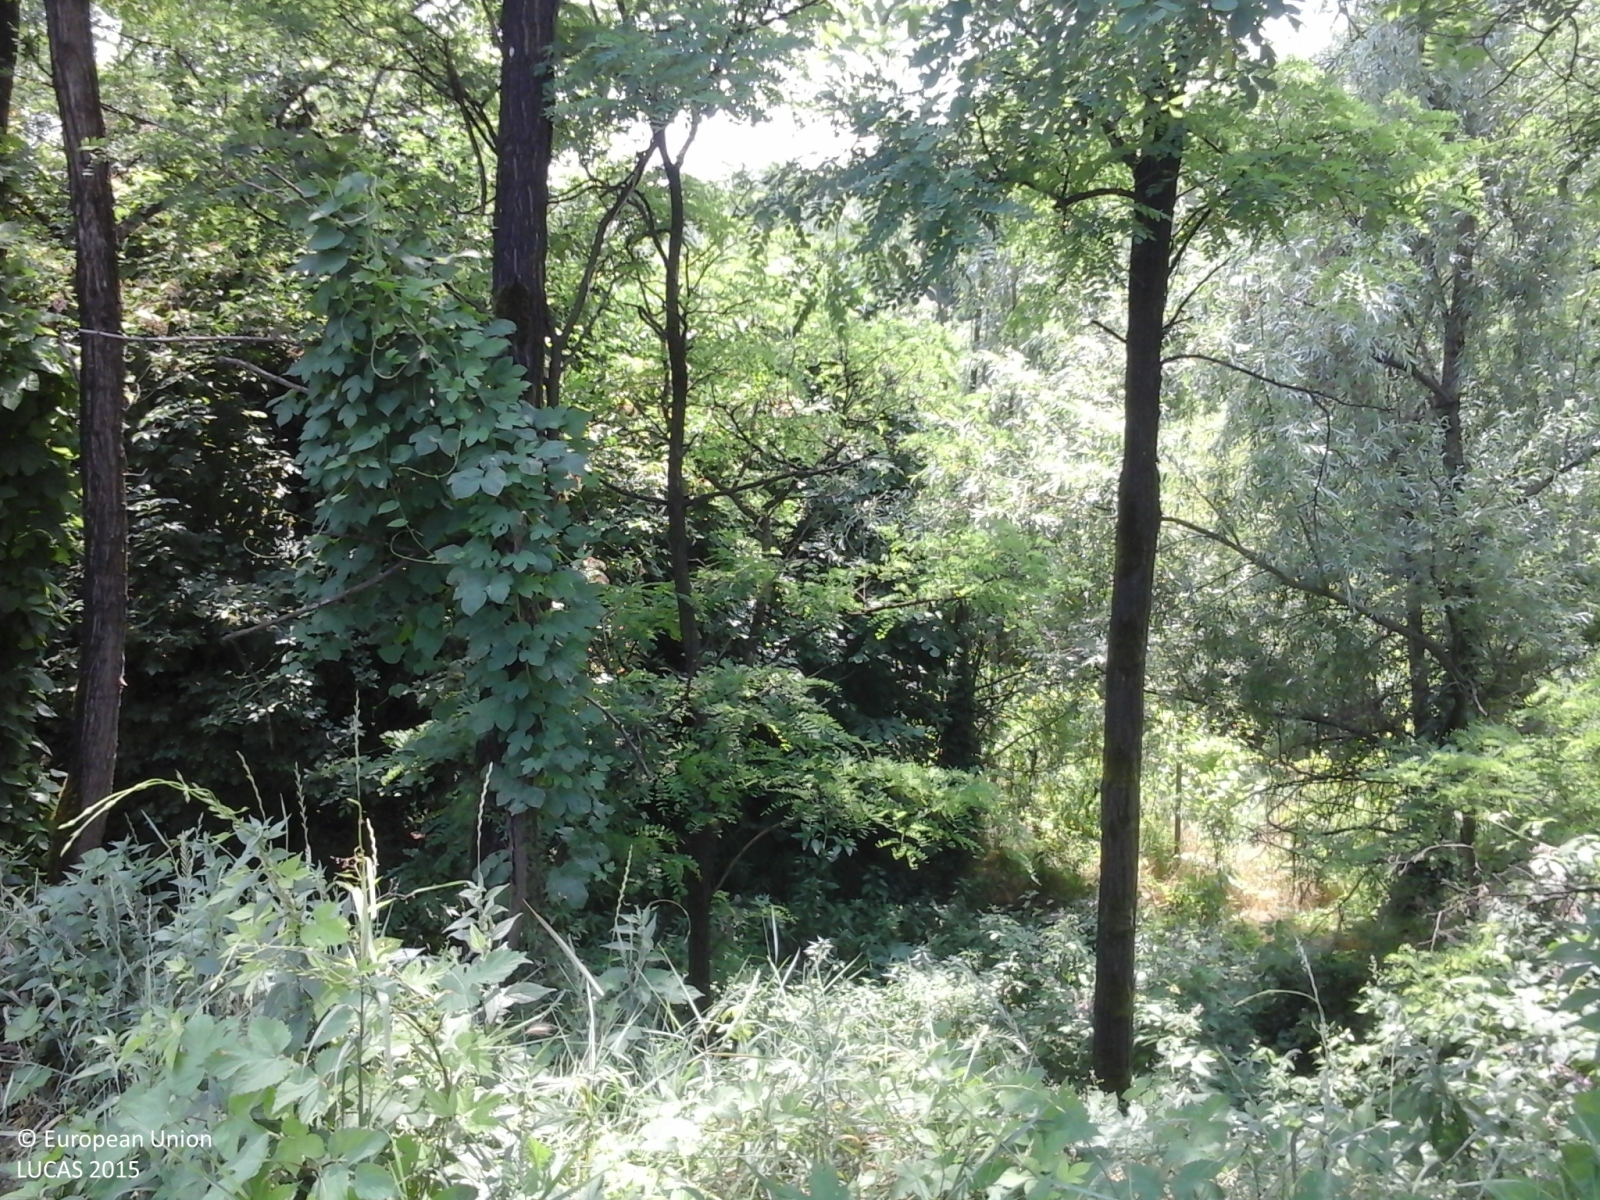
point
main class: Woodland
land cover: Broadleaved woodland
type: thermophilous deciduous forest
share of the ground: > 75 %
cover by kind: broadleaved forest trees 100 %
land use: Forestry
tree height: > 5 m
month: June
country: IT
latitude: 45.1786
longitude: 9.4538
